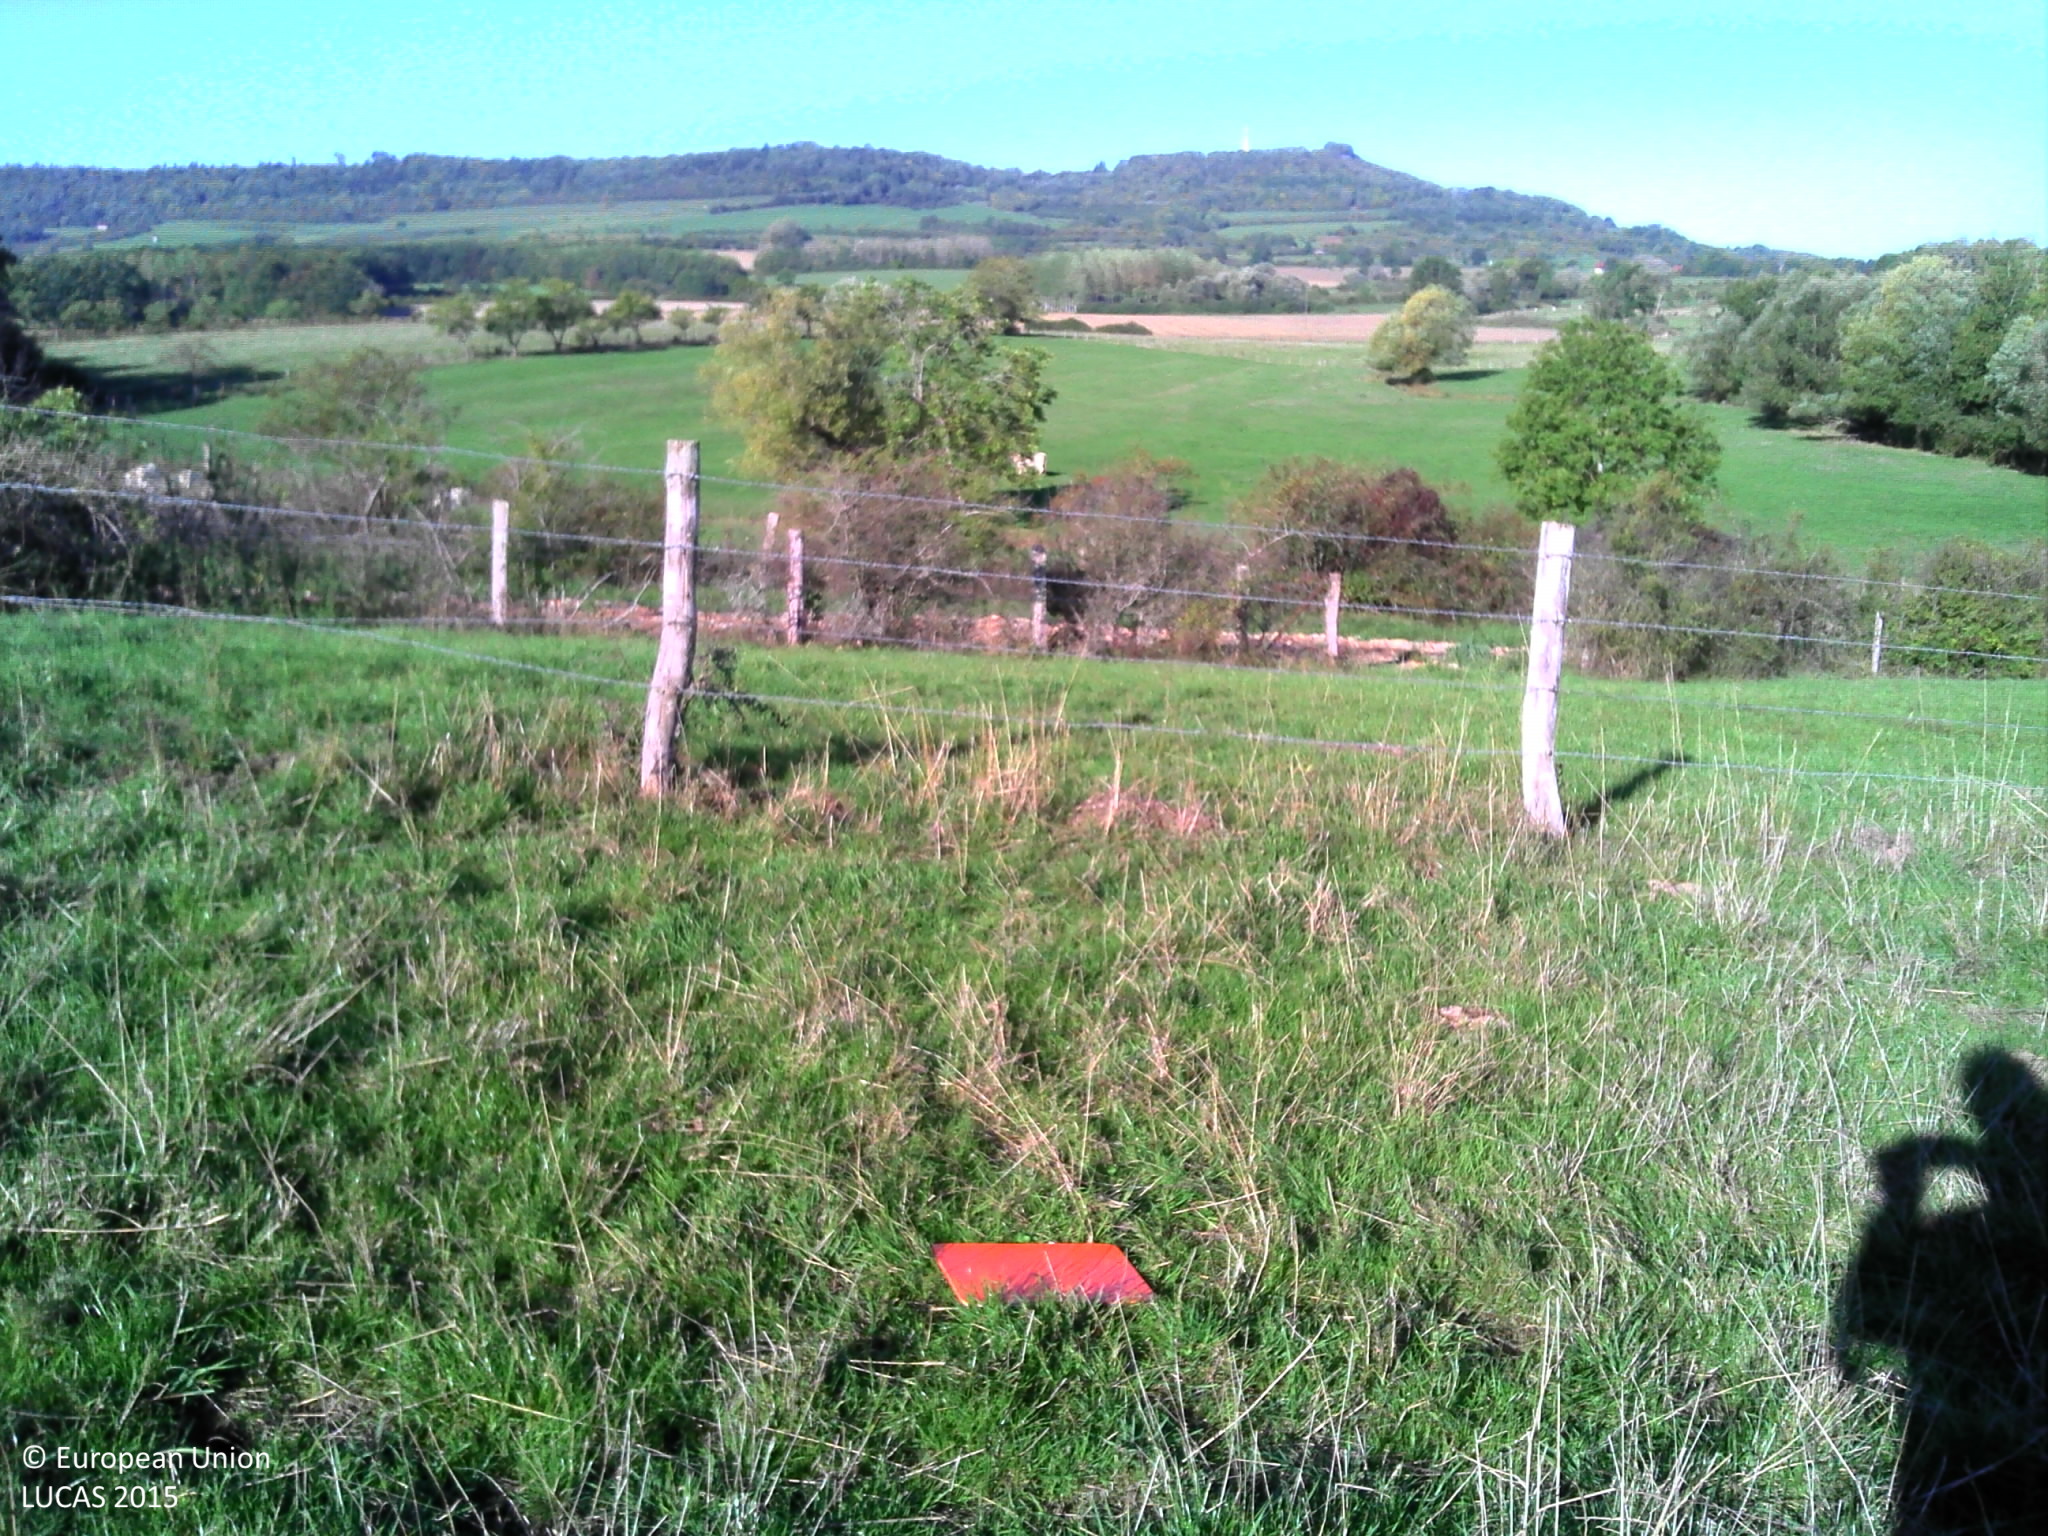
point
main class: Grassland
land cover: Grassland without tree/shrub cover
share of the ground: > 75 %
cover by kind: herbaceous plants 95 %, consolidated bare surface 5 %
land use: Agriculture (excluding fallow land and kitchen gardens)
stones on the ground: < 10 %
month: September
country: FR
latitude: 48.4256
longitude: 6.1217
